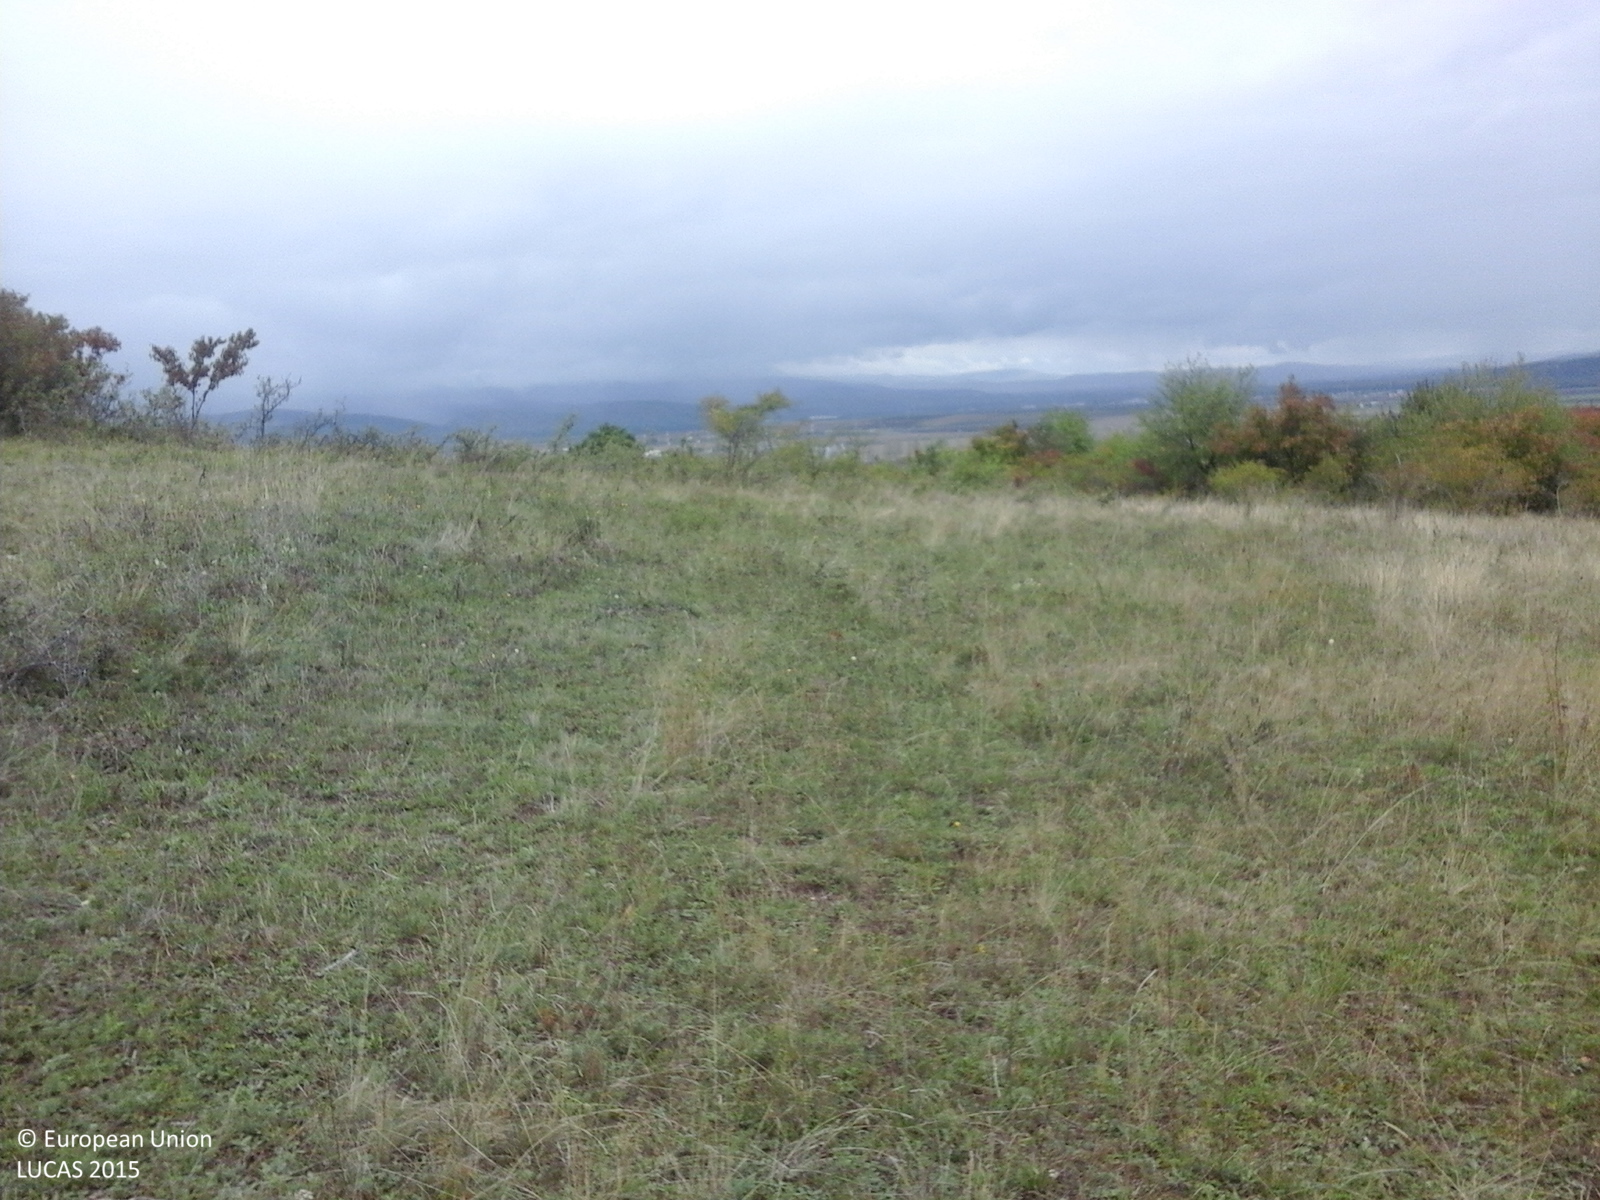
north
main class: Grassland
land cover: Grassland without tree/shrub cover
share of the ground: > 75 %
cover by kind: herbaceous plants 100 %
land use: Agriculture (excluding fallow land and kitchen gardens)
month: September
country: RO
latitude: 45.9446
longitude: 23.5187
